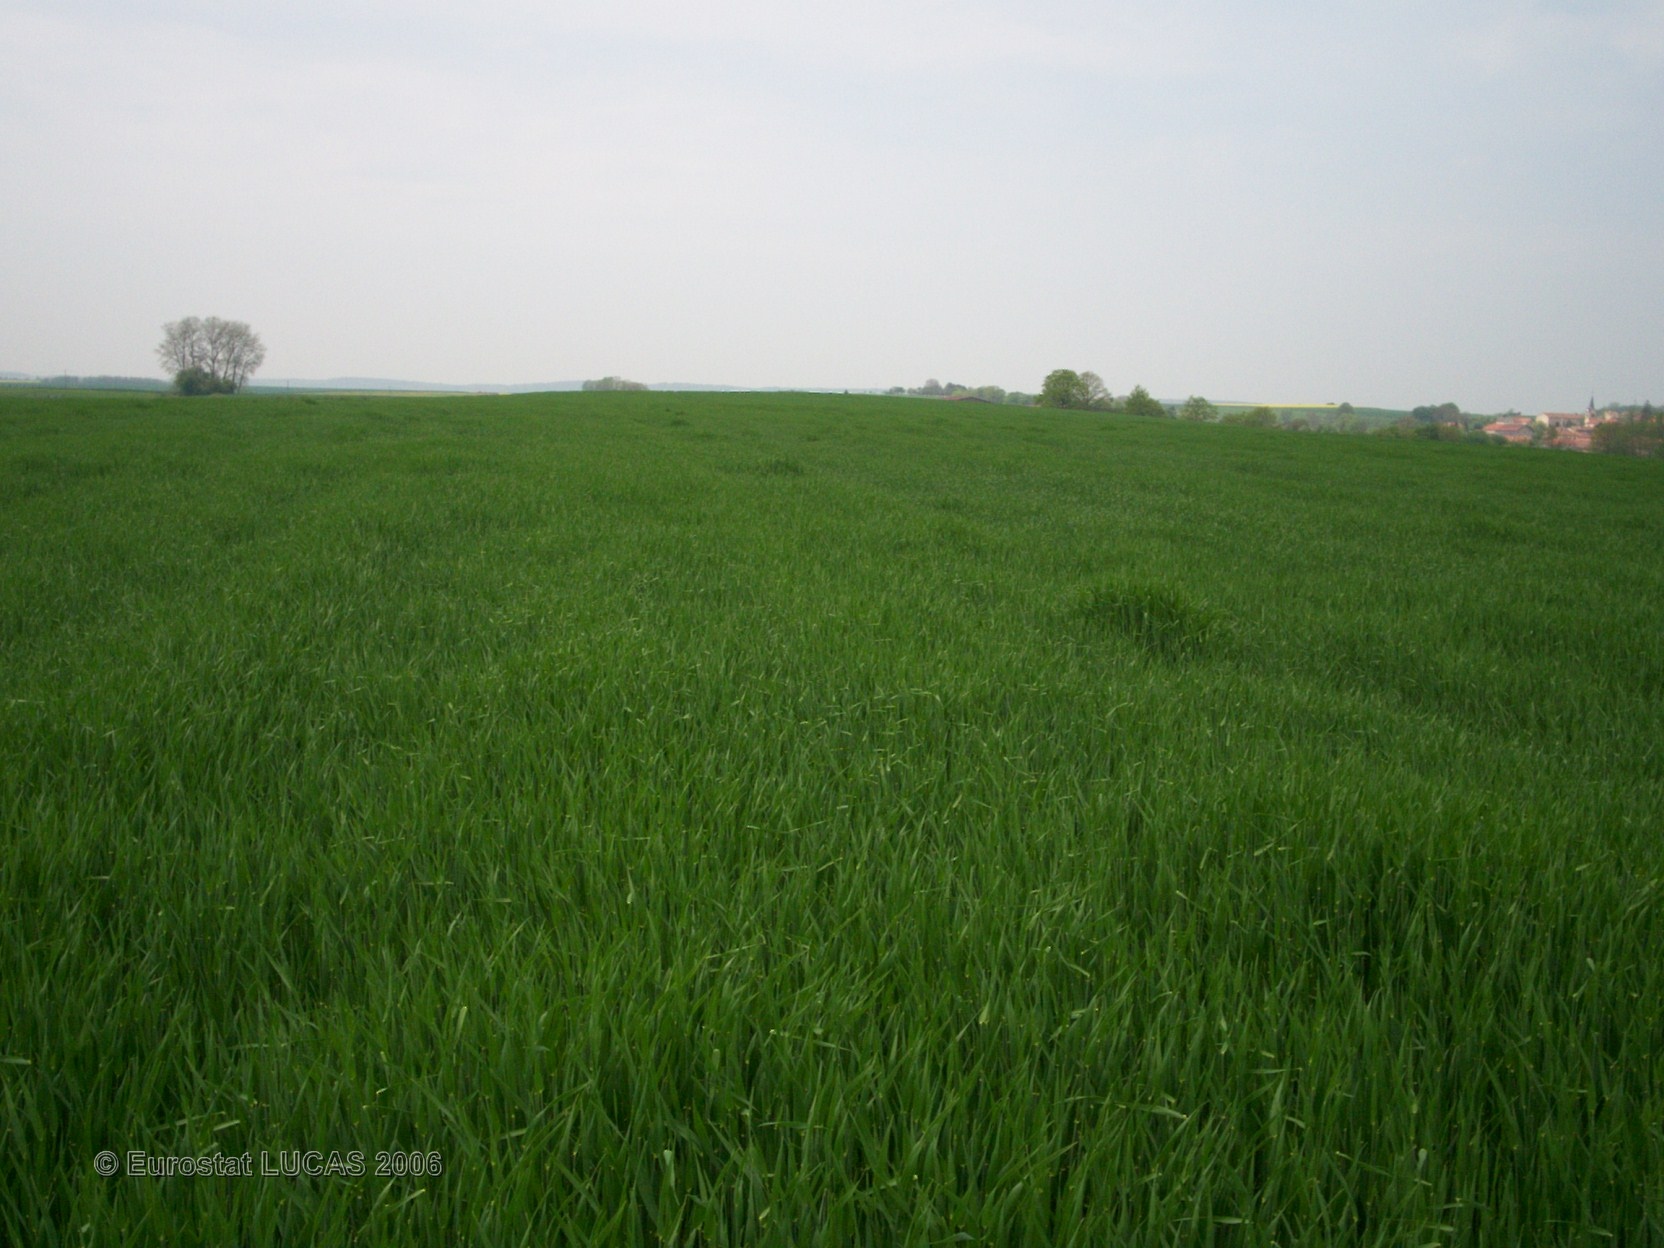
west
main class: Cropland
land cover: Barley
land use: Agriculture (excluding fallow land and kitchen gardens)
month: May
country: FR
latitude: 48.8433
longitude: 6.7983
